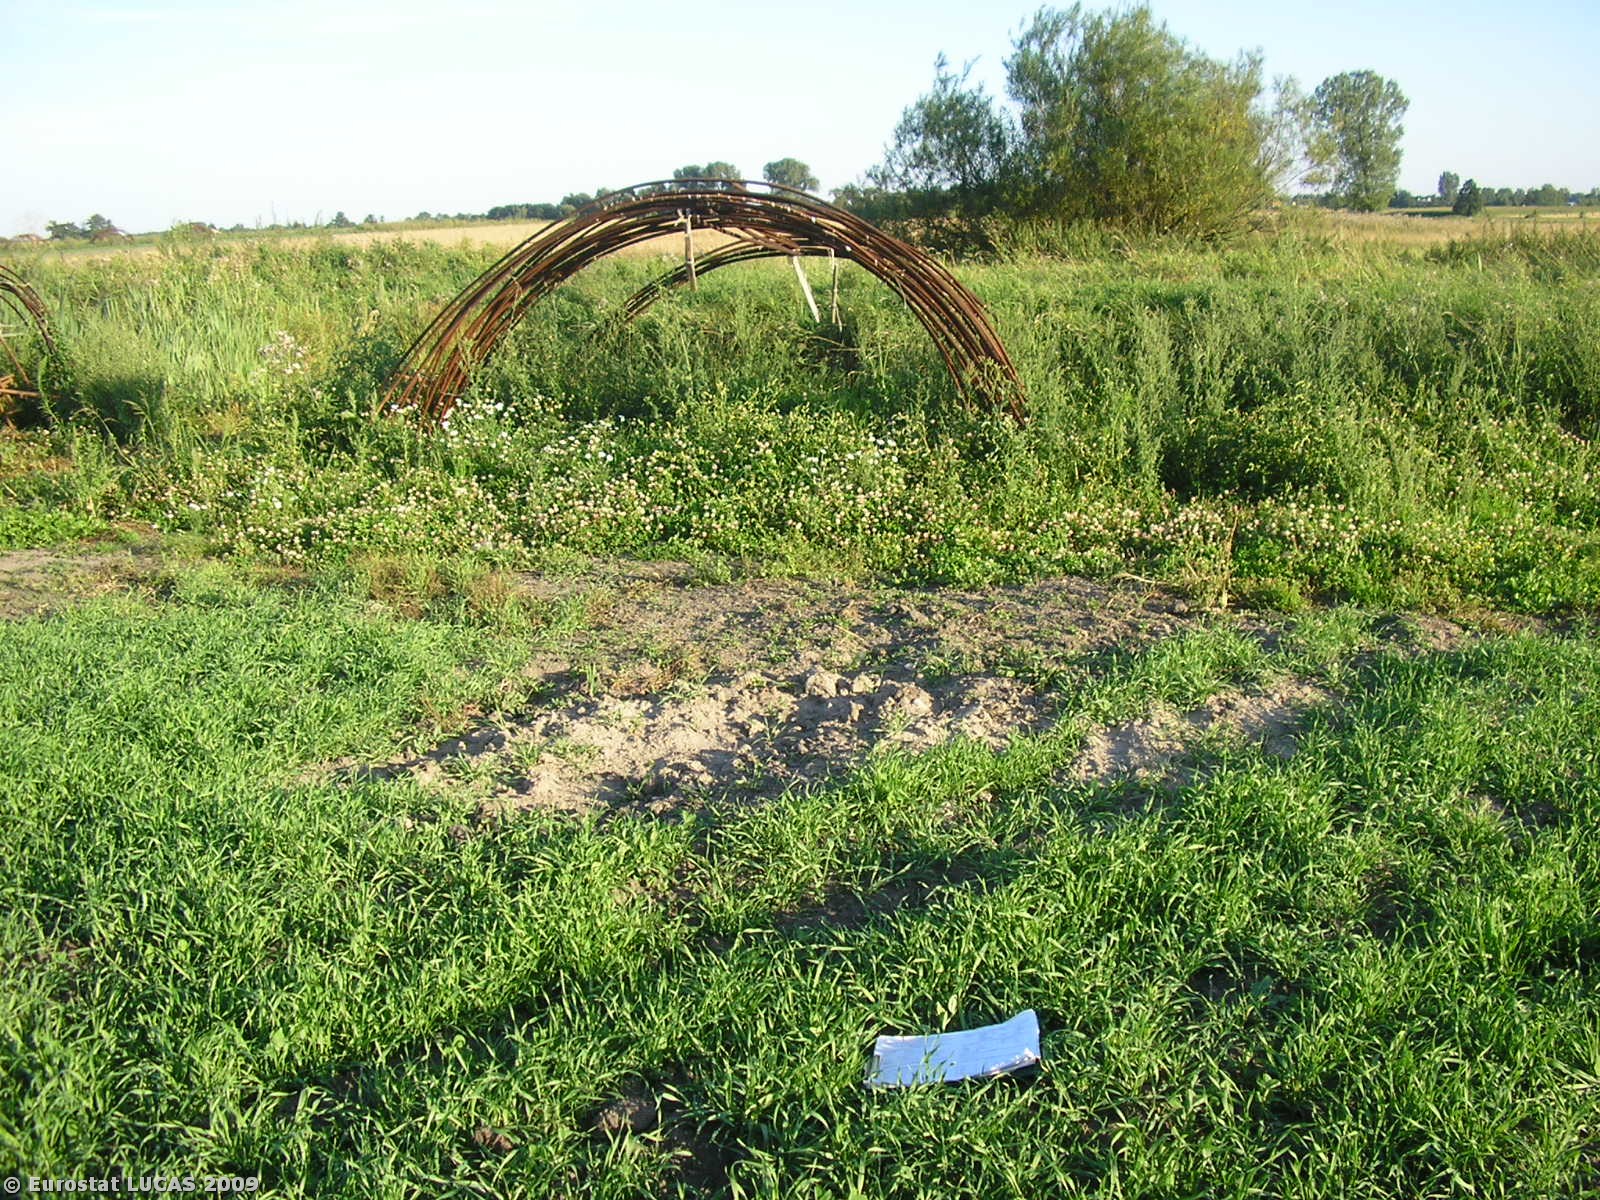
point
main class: Grassland
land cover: Grassland without tree/shrub cover
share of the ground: > 75 %
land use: Agriculture (excluding fallow land and kitchen gardens)
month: August
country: PL
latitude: 52.0507
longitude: 19.4916
